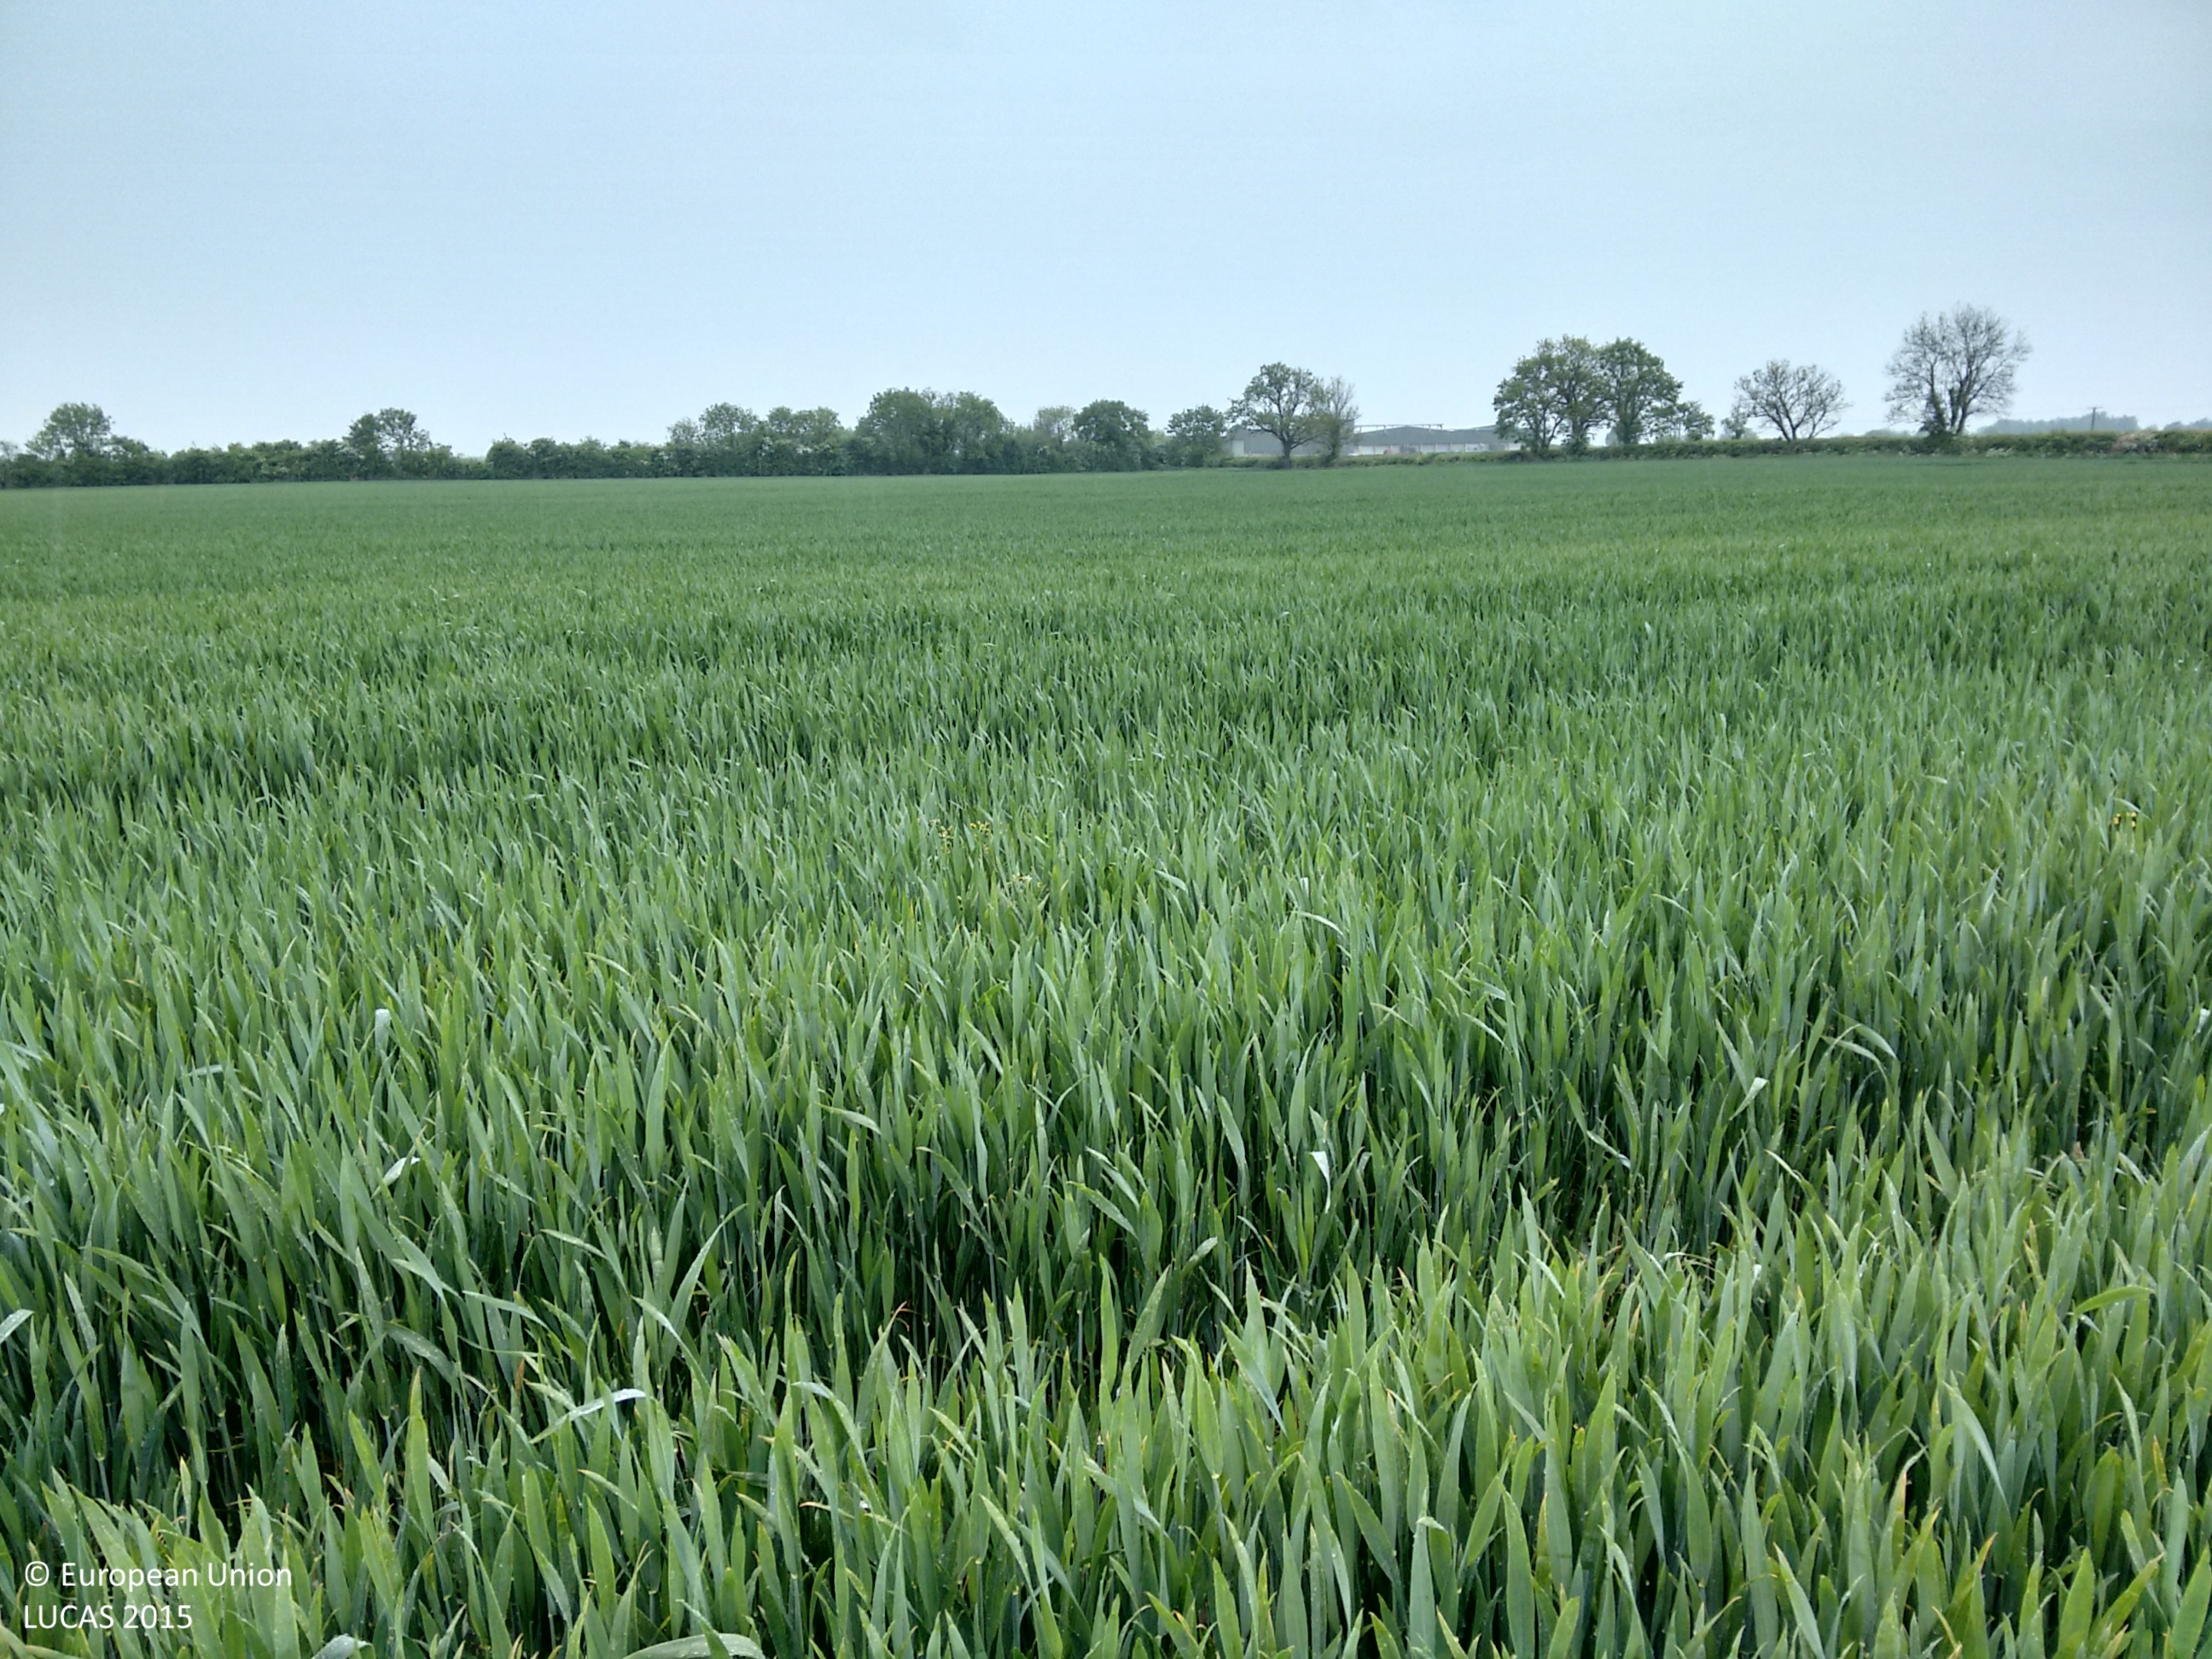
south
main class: Cropland
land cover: Common wheat
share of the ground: > 75 %
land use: Agriculture (excluding fallow land and kitchen gardens)
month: May
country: GB
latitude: 53.3758
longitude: -0.3320
